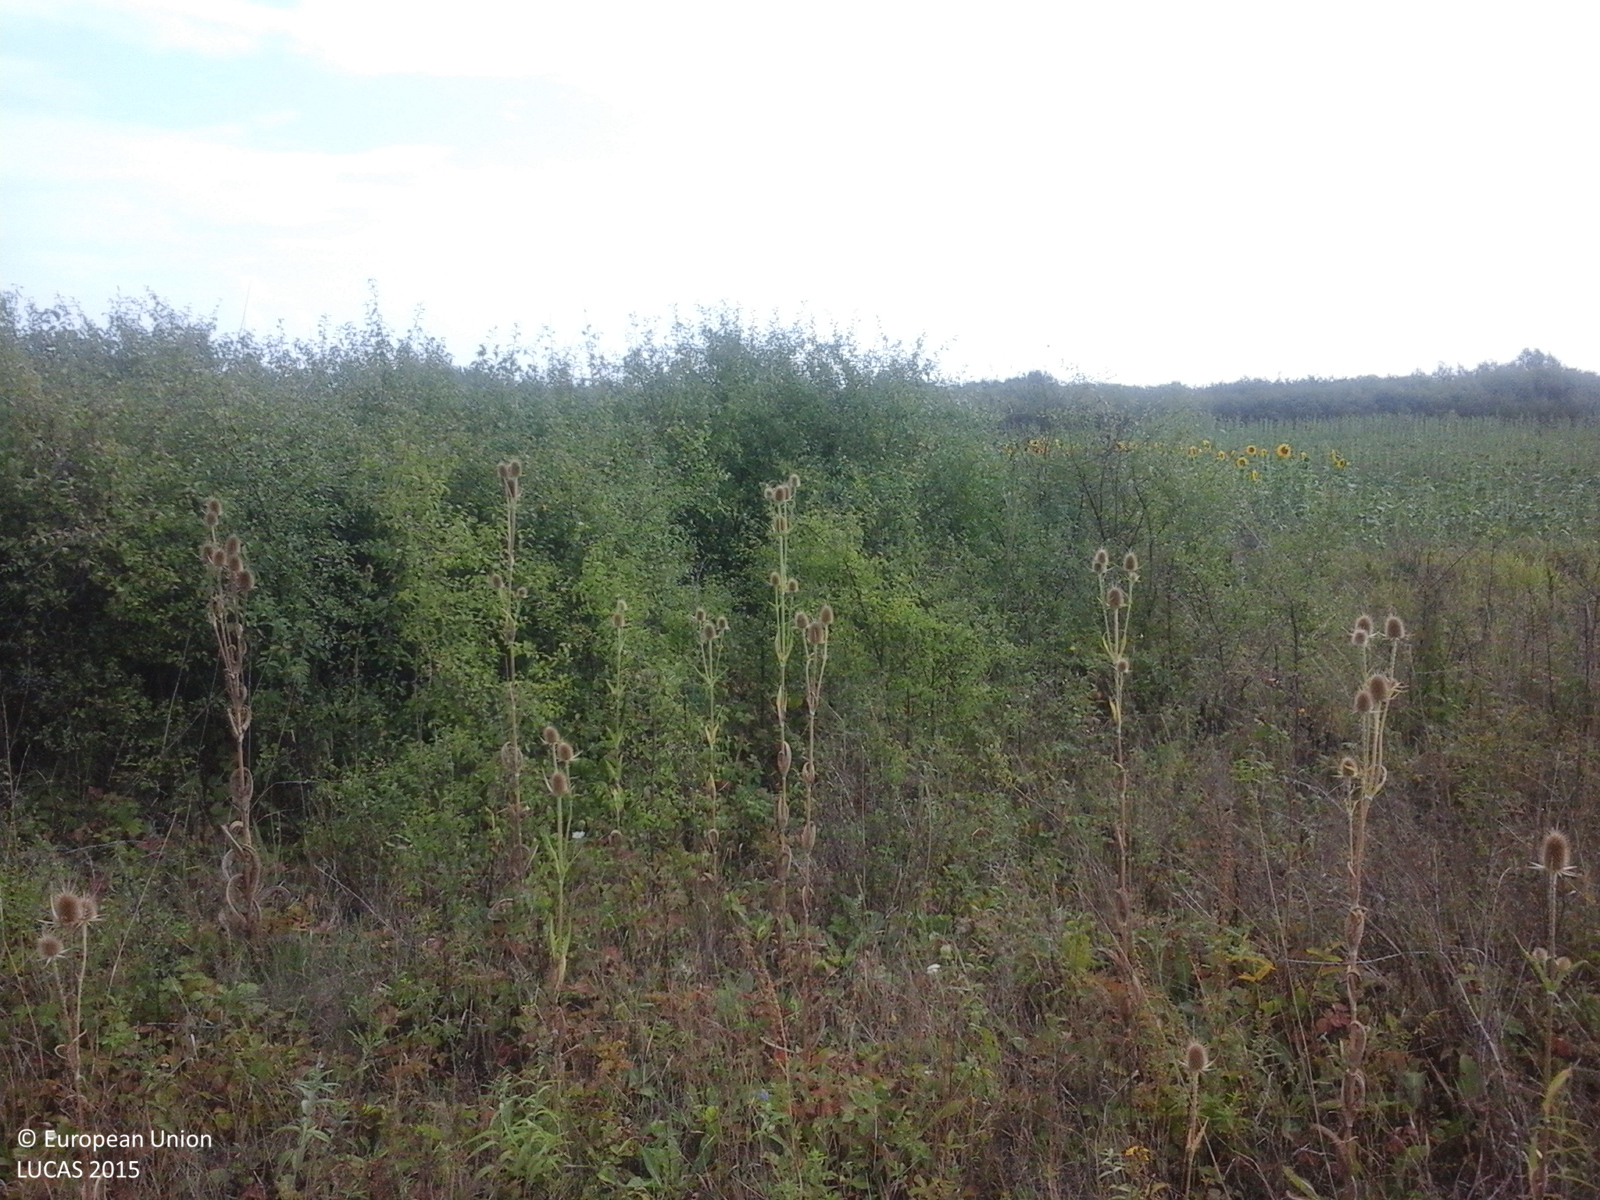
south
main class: Grassland
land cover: Grassland with sparse tree/shrub cover
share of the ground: > 75 %
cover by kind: herbaceous plants 85 %, shrubs 10 %, broadleaved forest trees 5 %
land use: Fallow land
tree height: < 5 m
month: August
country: RO
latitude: 46.5365
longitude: 21.7634
